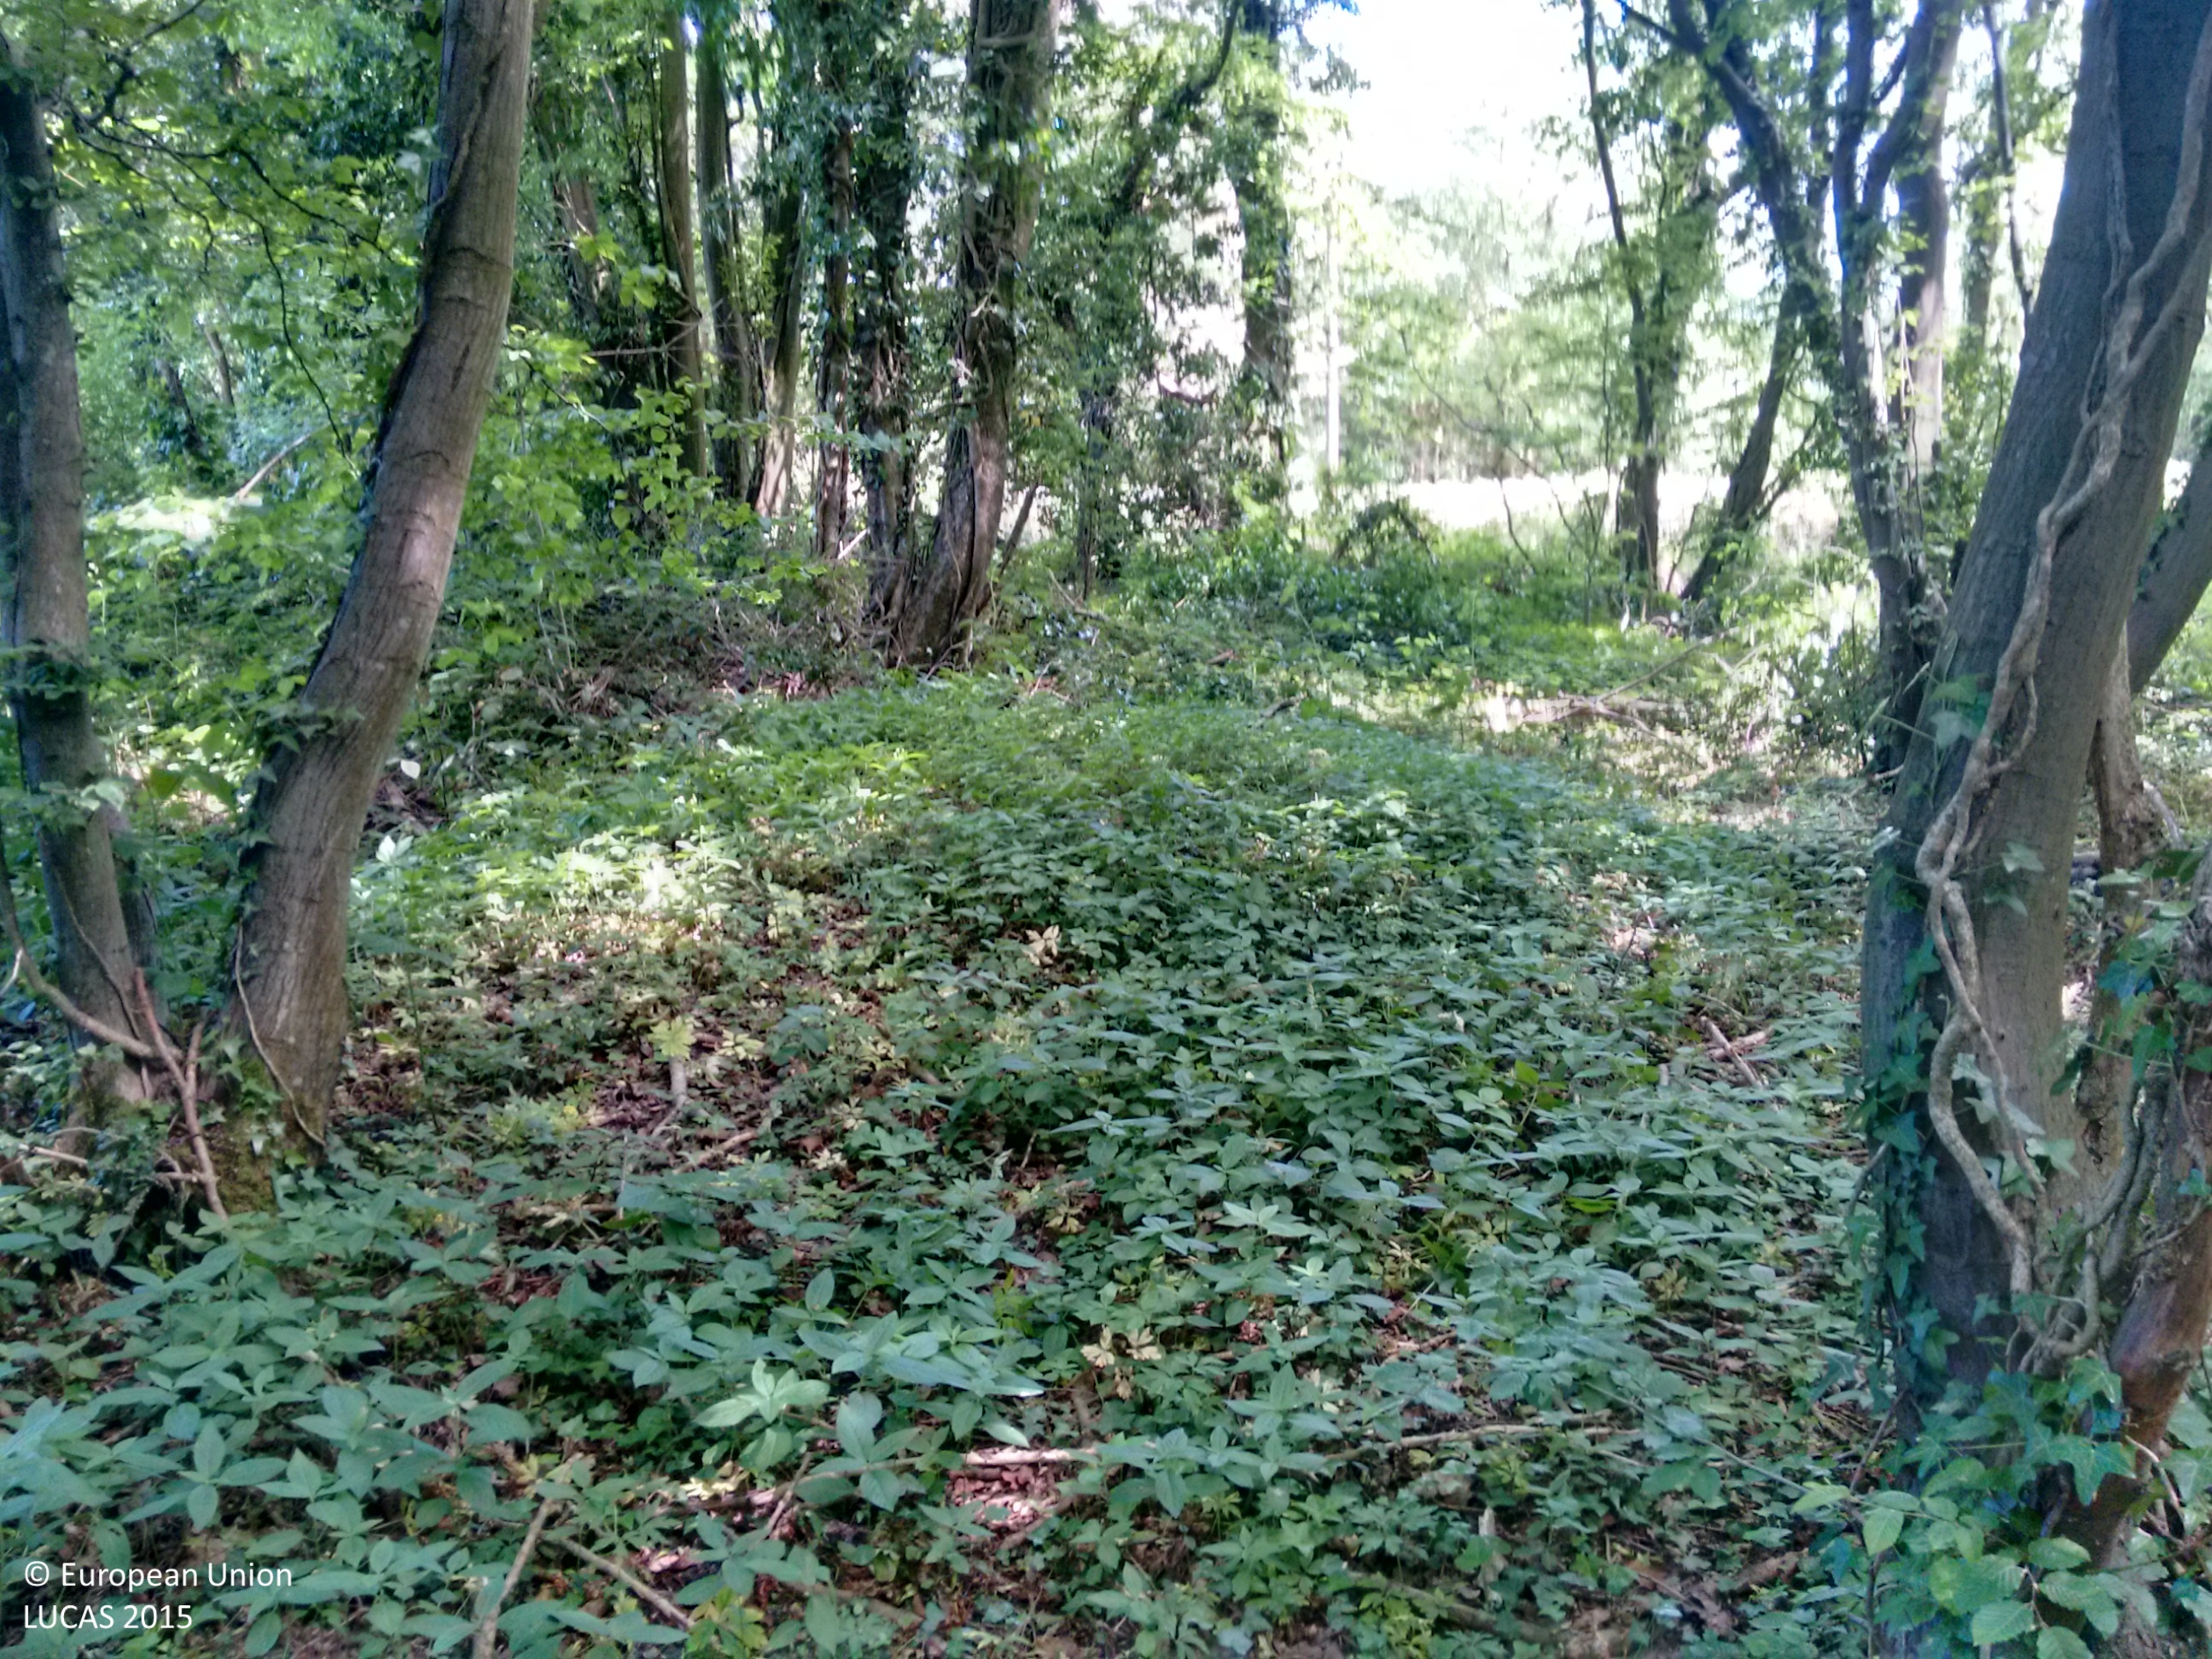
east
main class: Woodland
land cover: Broadleaved woodland
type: mesophytic deciduous forest
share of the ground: > 75 %
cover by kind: broadleaved forest trees 100 %
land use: Semi-natural and natural areas not in use
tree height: > 5 m
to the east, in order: Broadleaved woodland; Tracks; Fences; Broadleaved woodland; Tracks; Broadleaved woodland; Rivers and streams; Broadleaved woodland; Fences; Grassland without tree/shrub cover
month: June
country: GB
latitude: 50.9376
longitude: 0.6238
